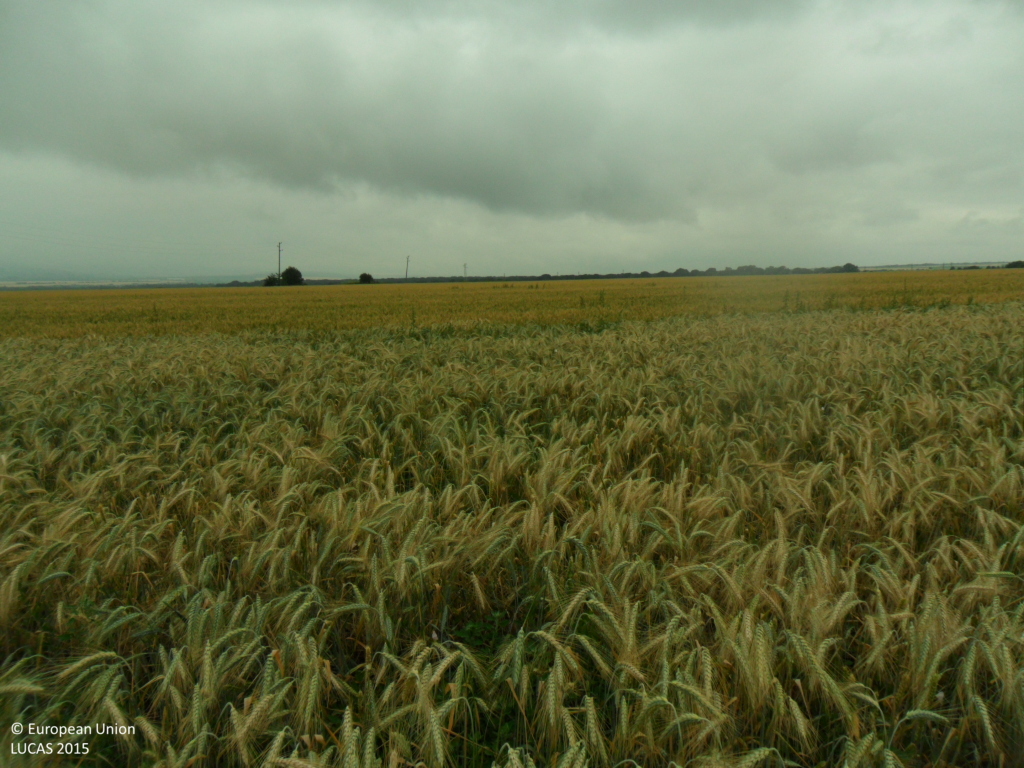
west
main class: Cropland
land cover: Common wheat
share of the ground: > 75 %
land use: Agriculture (excluding fallow land and kitchen gardens)
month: June
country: BG
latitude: 43.3438
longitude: 26.9779
